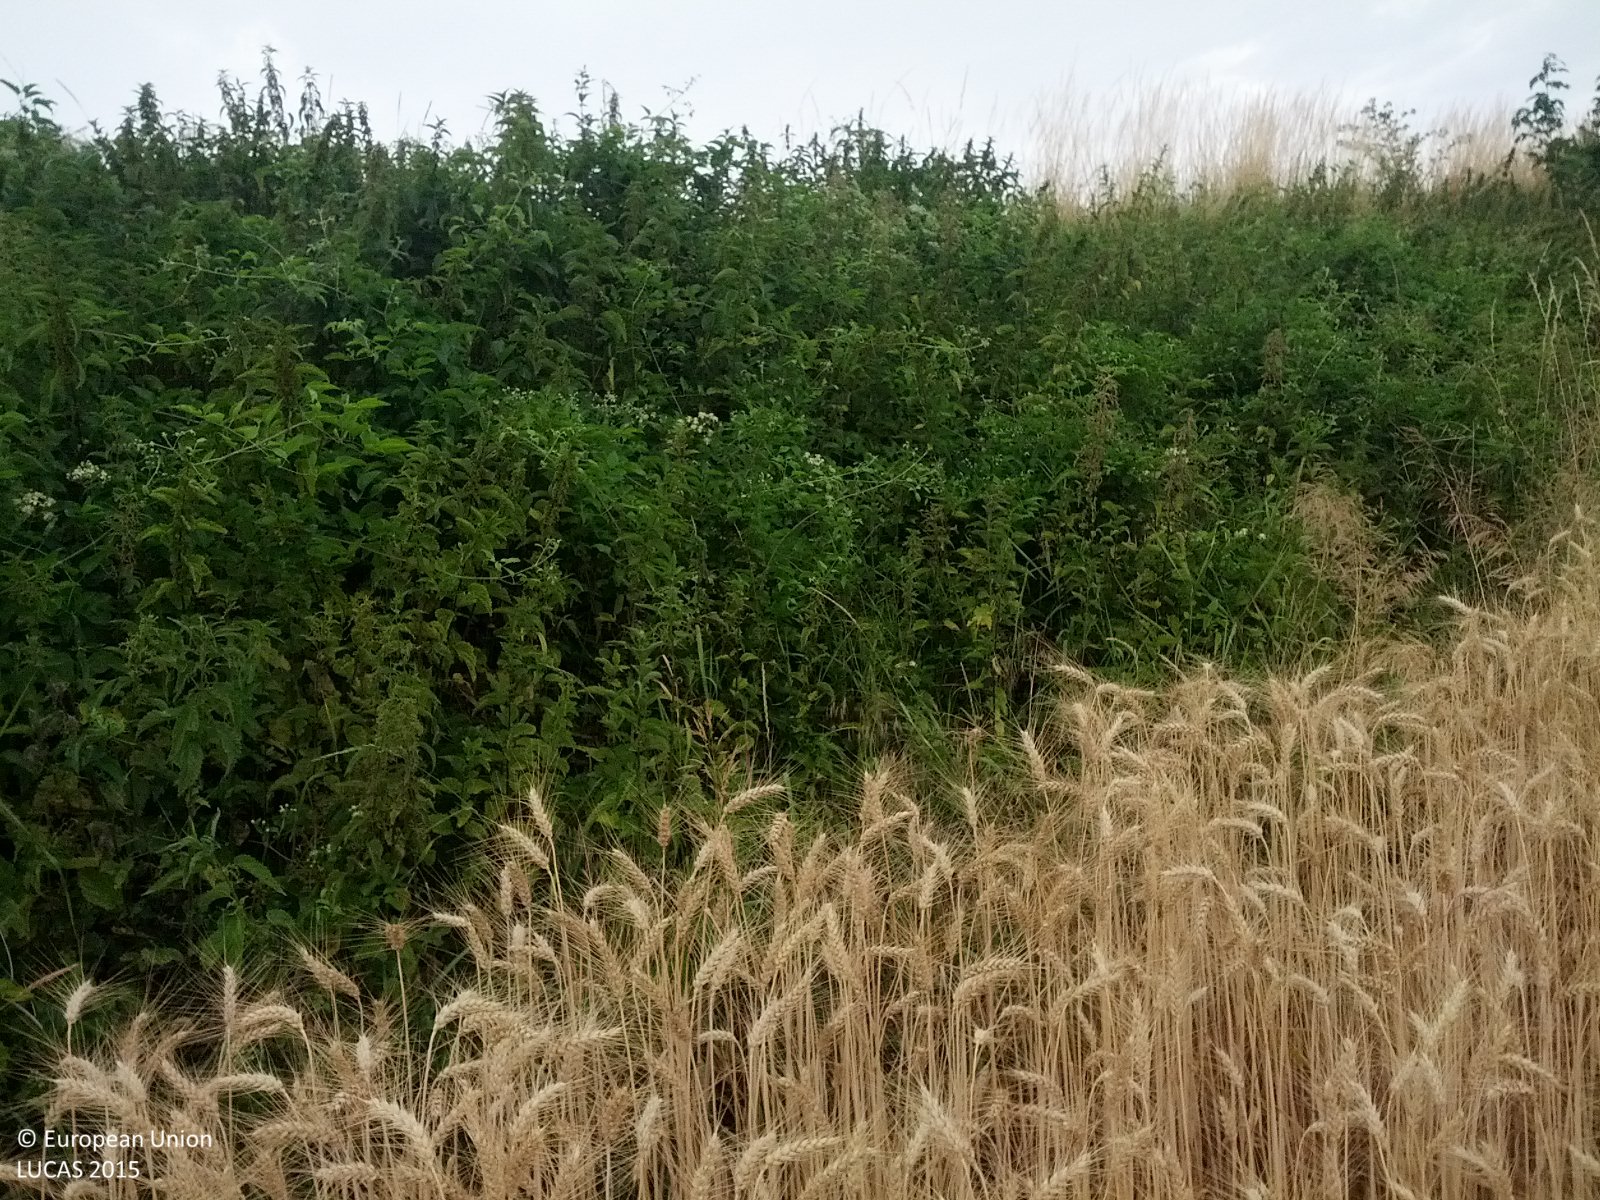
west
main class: Cropland
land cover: Common wheat
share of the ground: > 75 %
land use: Agriculture (excluding fallow land and kitchen gardens)
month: July
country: AT
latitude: 48.7118
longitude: 16.5981
